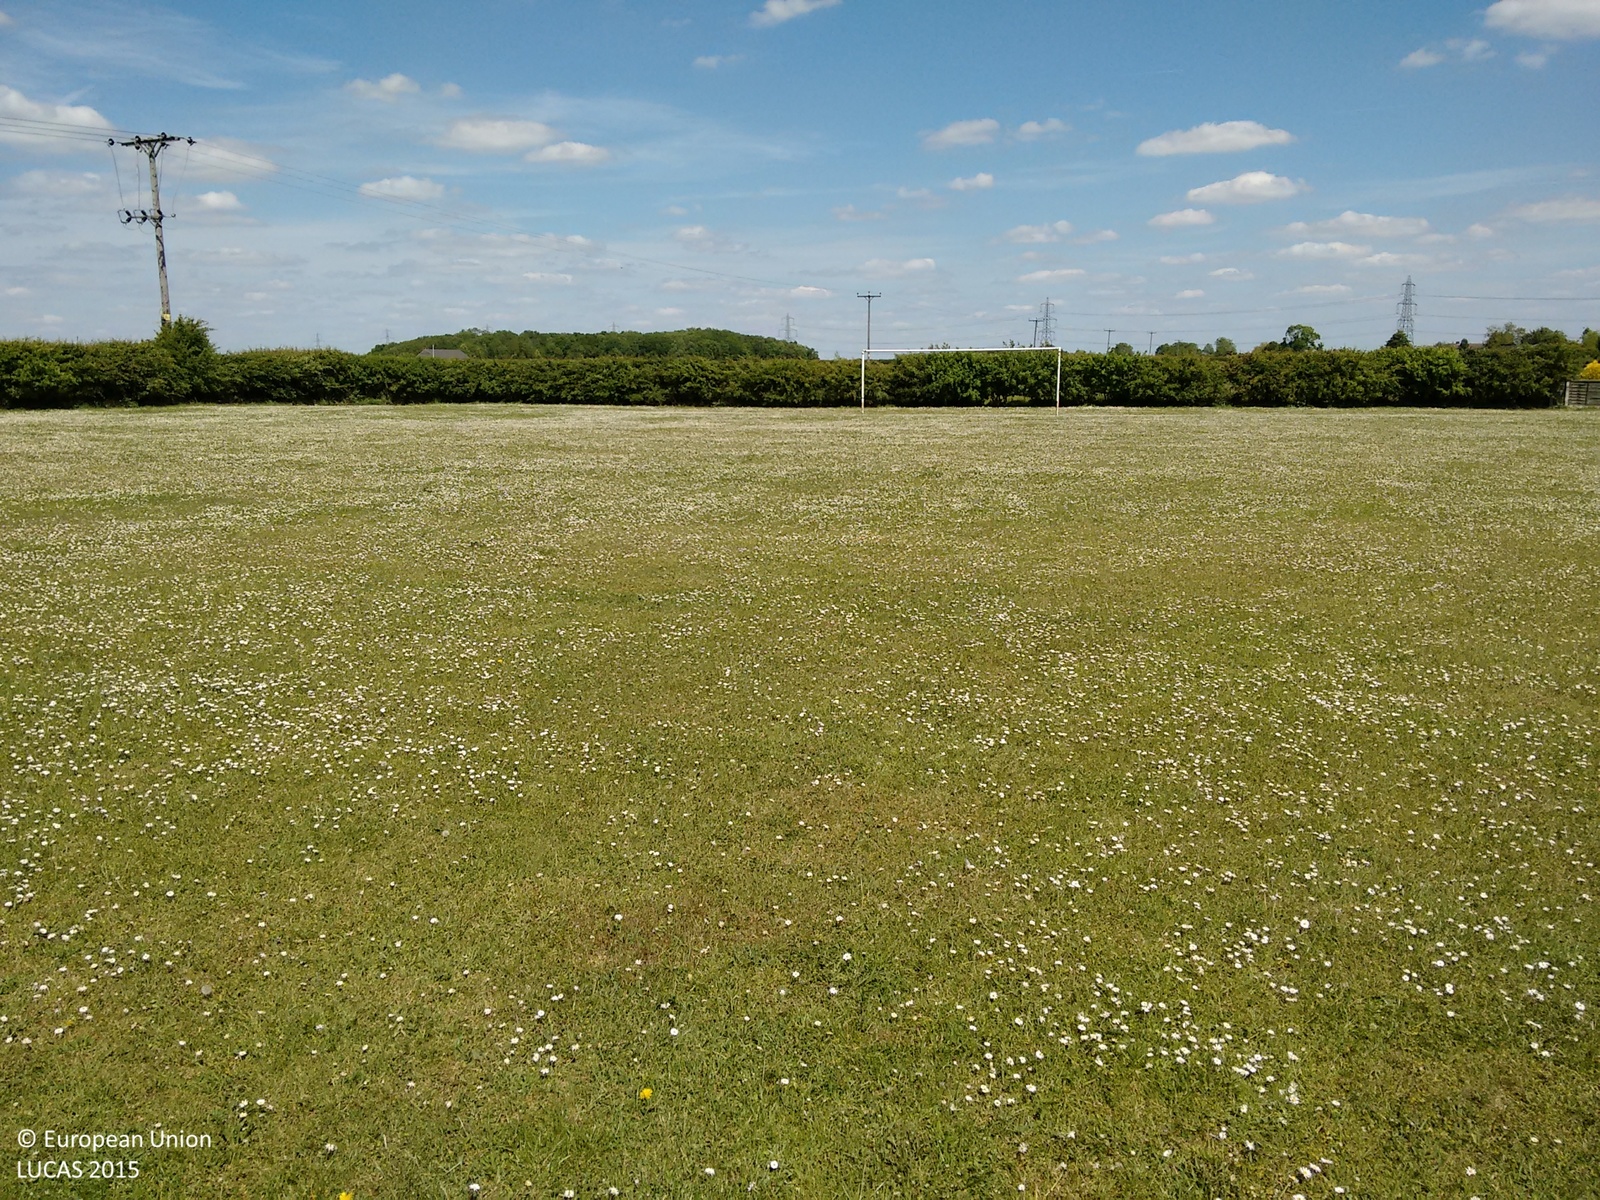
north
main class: Grassland
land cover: Grassland without tree/shrub cover
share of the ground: > 75 %
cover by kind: herbaceous plants 100 %
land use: Sport
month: June
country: GB
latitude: 52.6601
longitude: -0.4308
